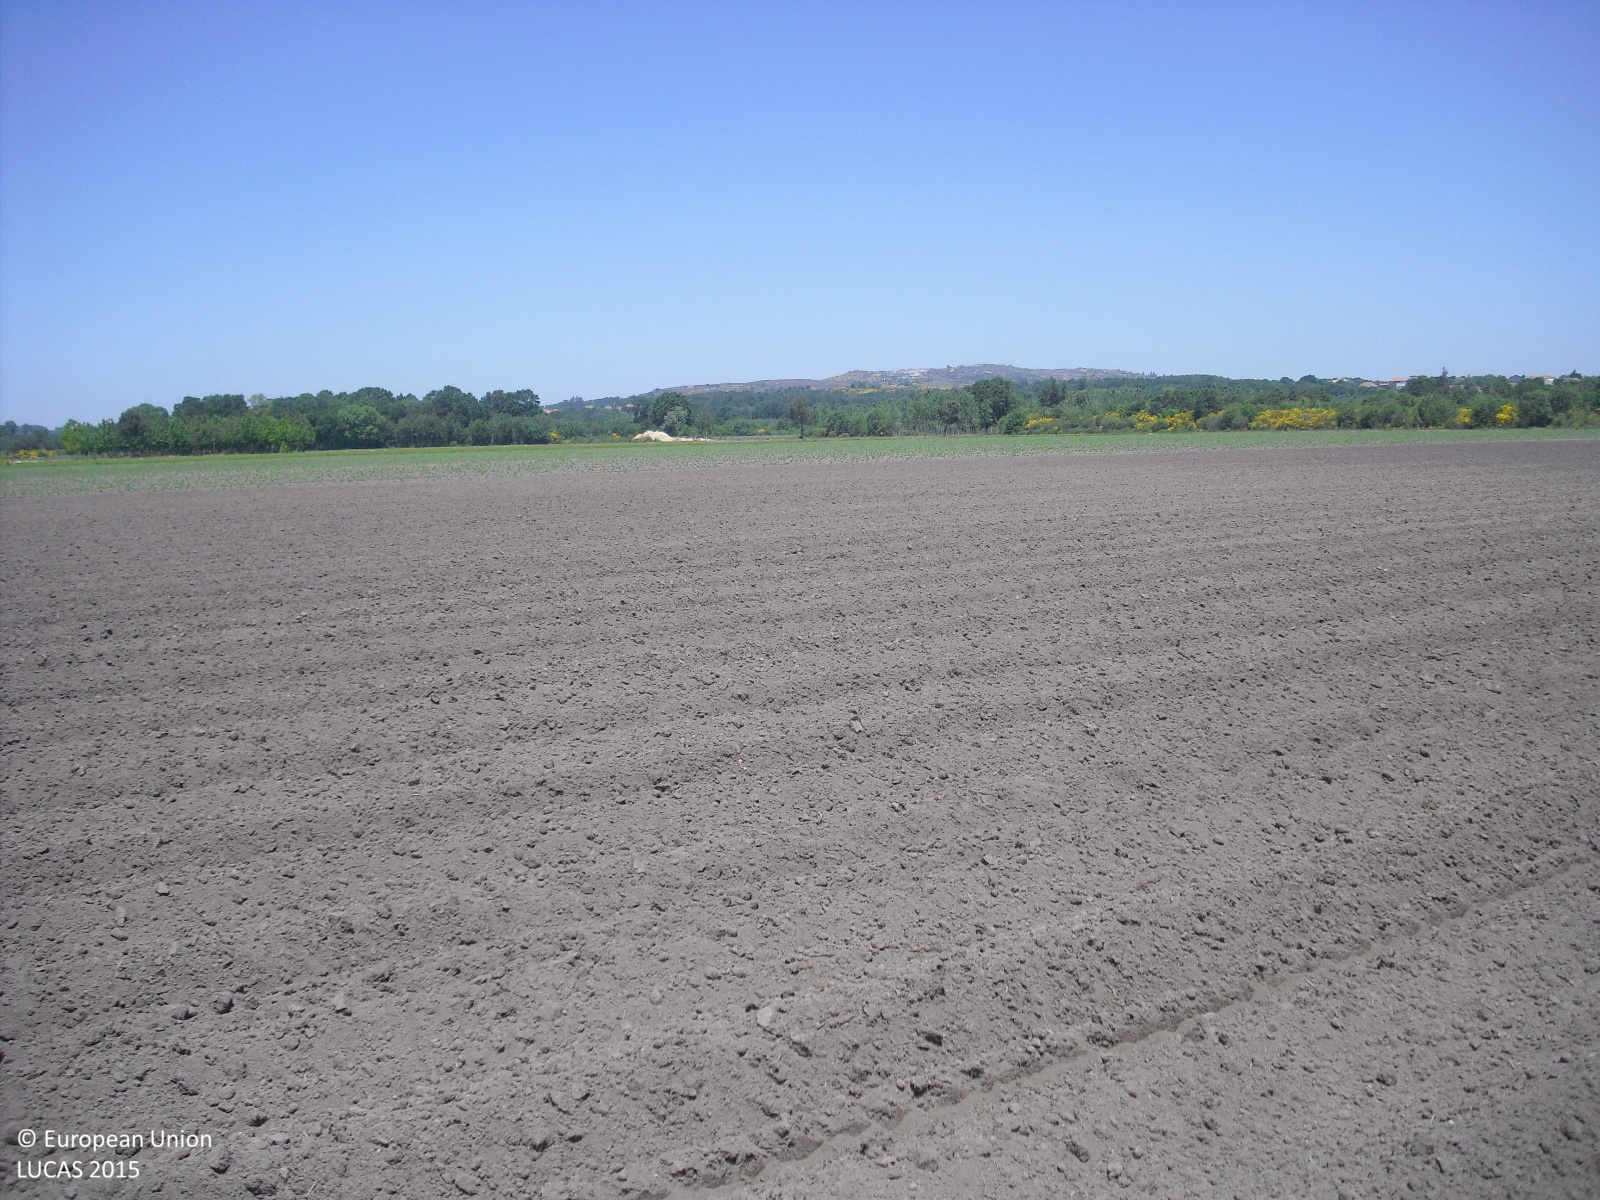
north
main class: Cropland
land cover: Potatoes
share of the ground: < 10 %
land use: Agriculture (excluding fallow land and kitchen gardens)
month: May
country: ES
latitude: 42.1500
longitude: -7.7015
